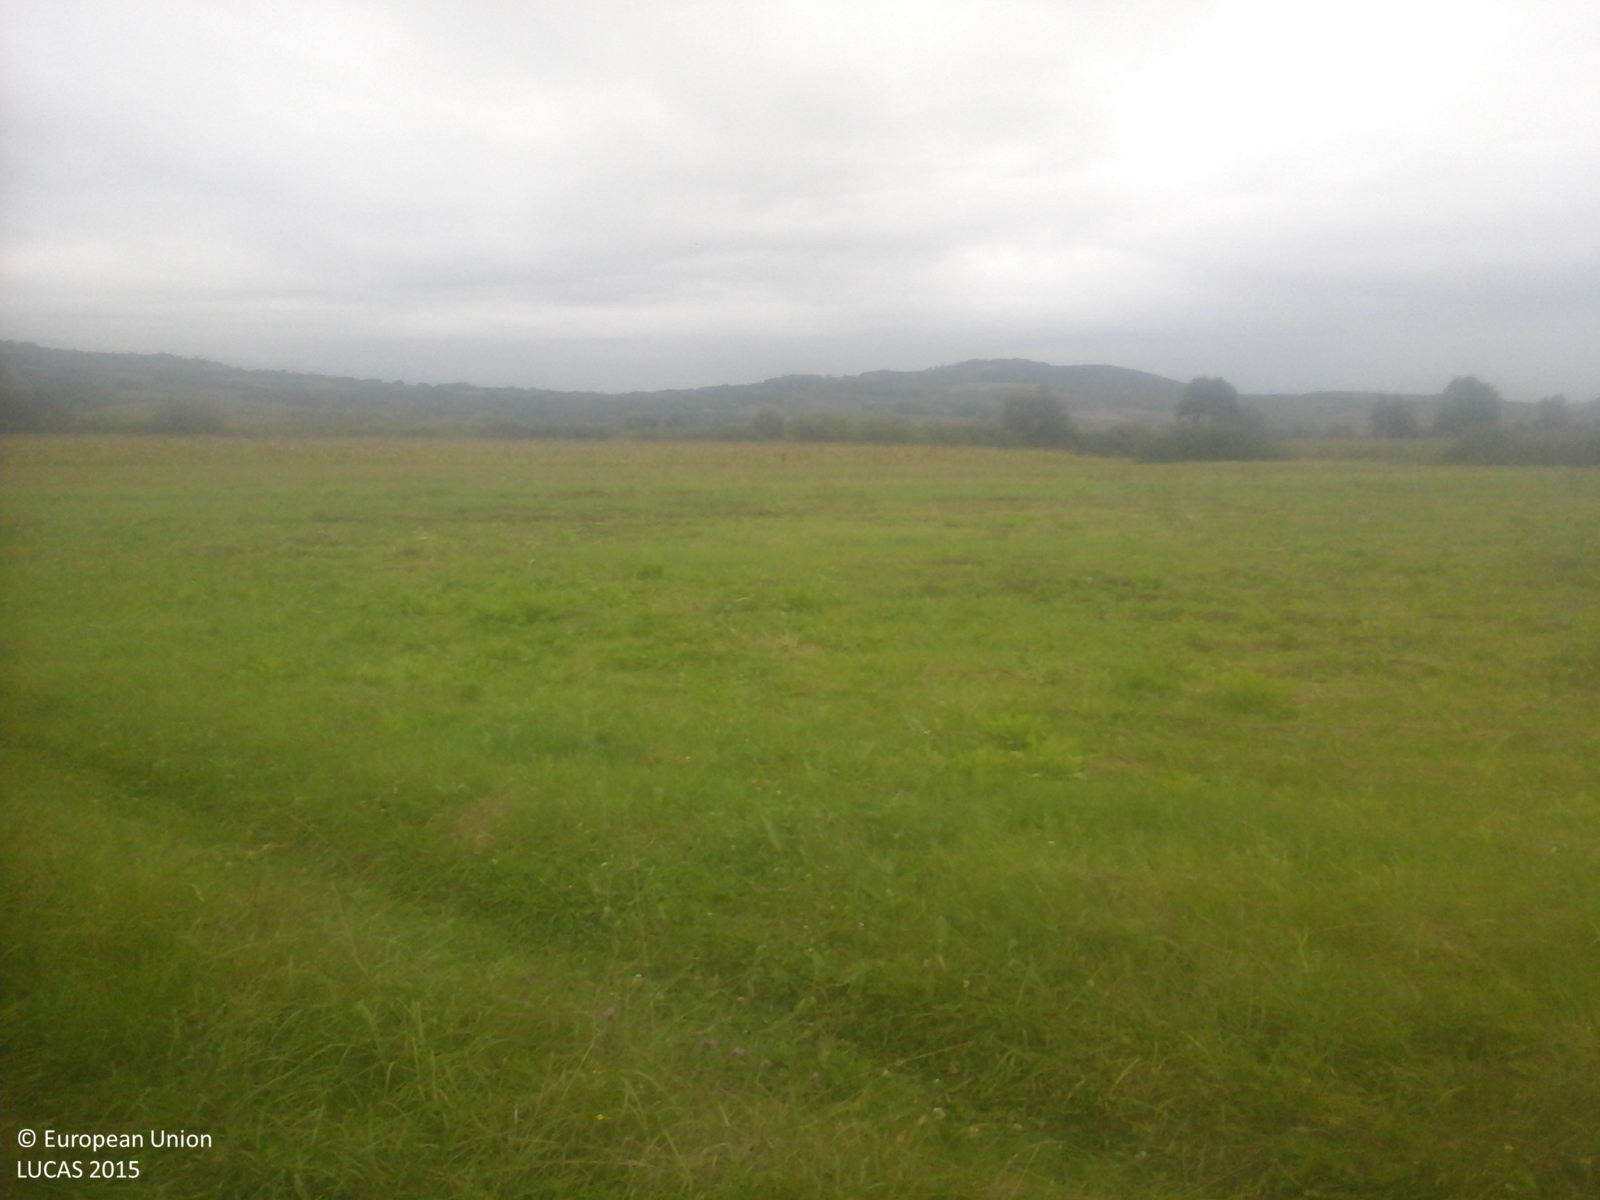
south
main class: Cropland
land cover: Maize
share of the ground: > 75 %
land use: Agriculture (excluding fallow land and kitchen gardens)
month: September
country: RO
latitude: 46.8123
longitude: 22.2241
